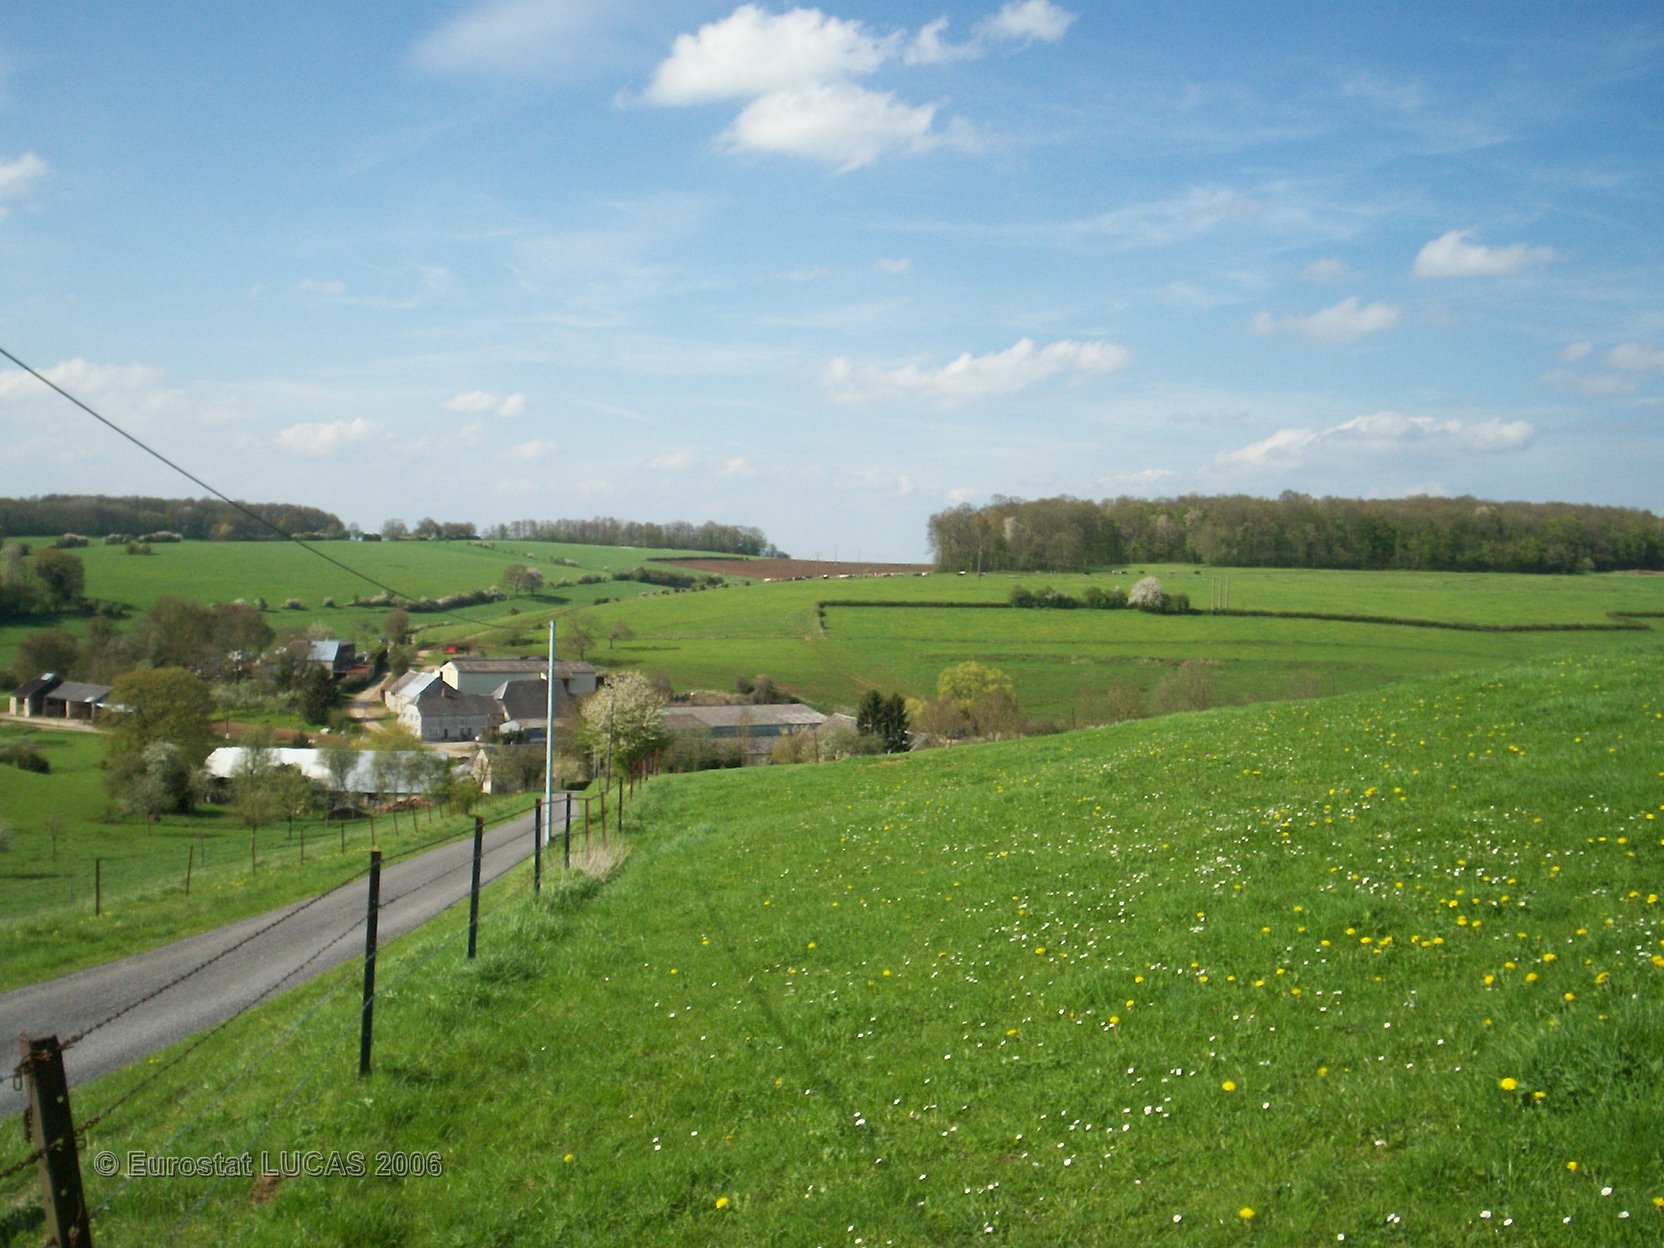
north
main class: Grassland
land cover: Grassland without tree/shrub cover
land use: Agriculture (excluding fallow land and kitchen gardens)
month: May
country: FR
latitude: 49.8079
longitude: 4.3122
